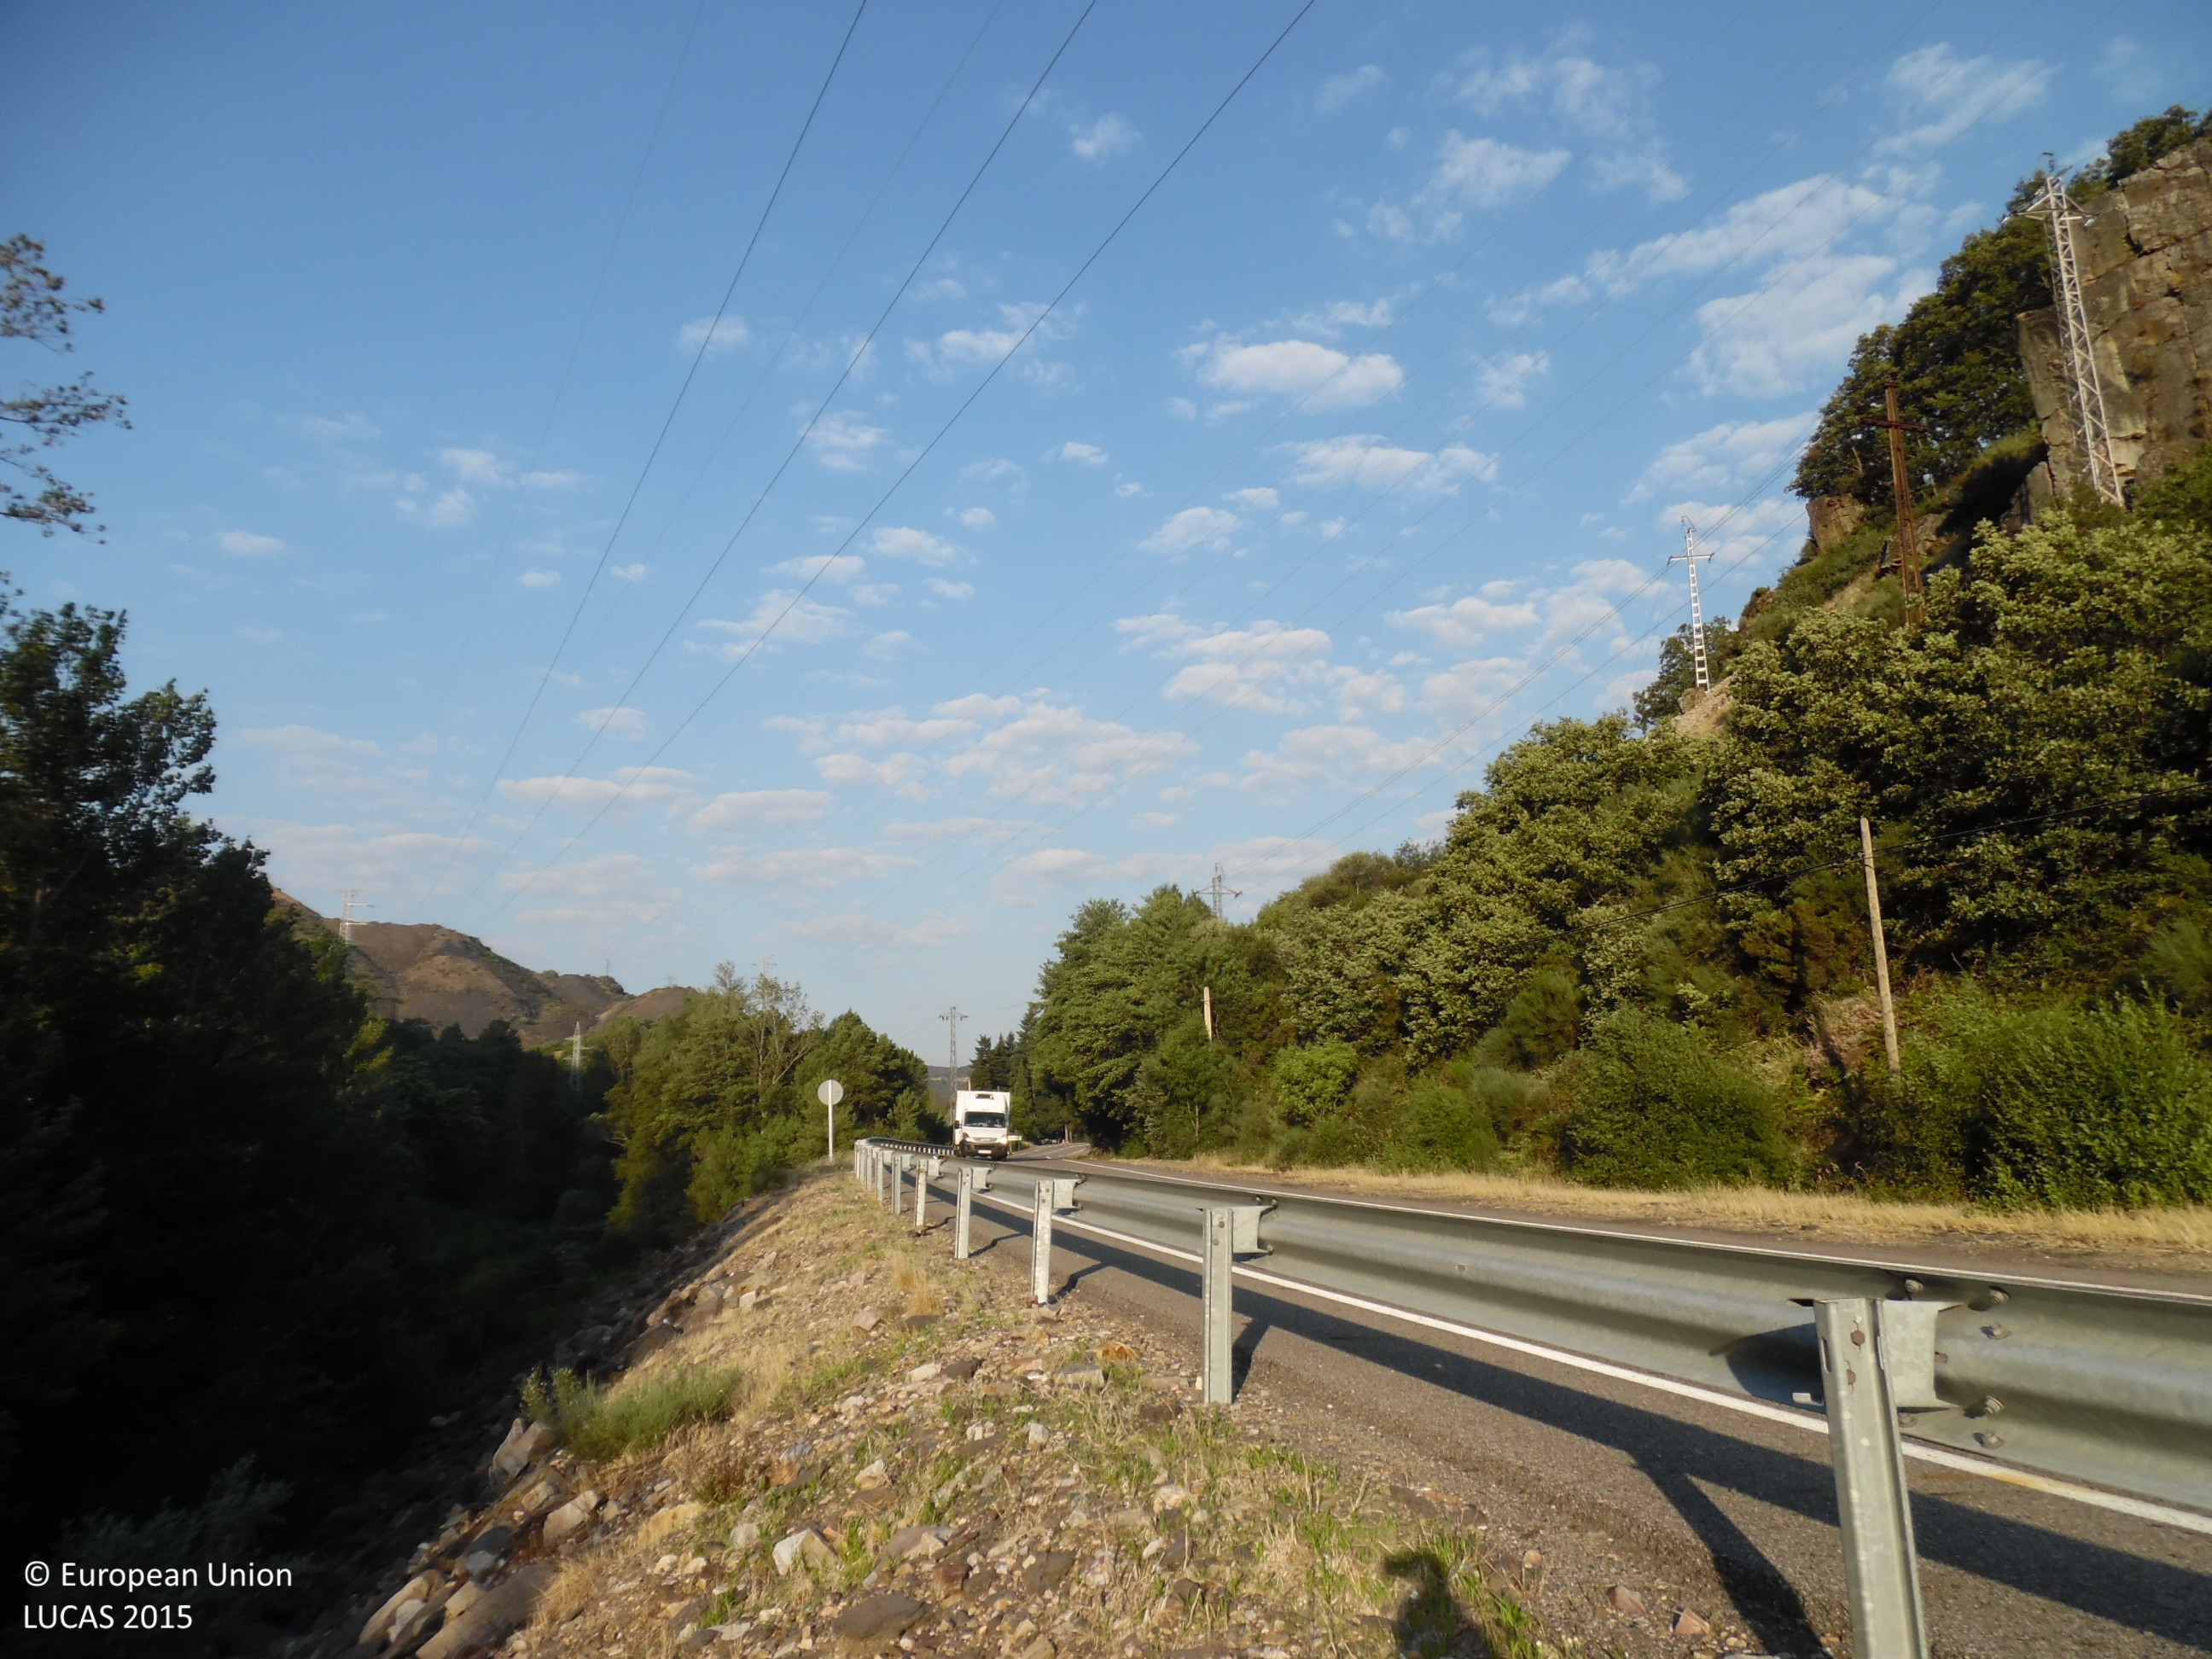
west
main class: Woodland
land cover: Broadleaved woodland
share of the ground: > 75 %
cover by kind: broadleaved forest trees 80 %, shrubs 5 %
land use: Forestry
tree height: > 5 m
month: June
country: ES
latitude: 42.8383
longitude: -6.4783
